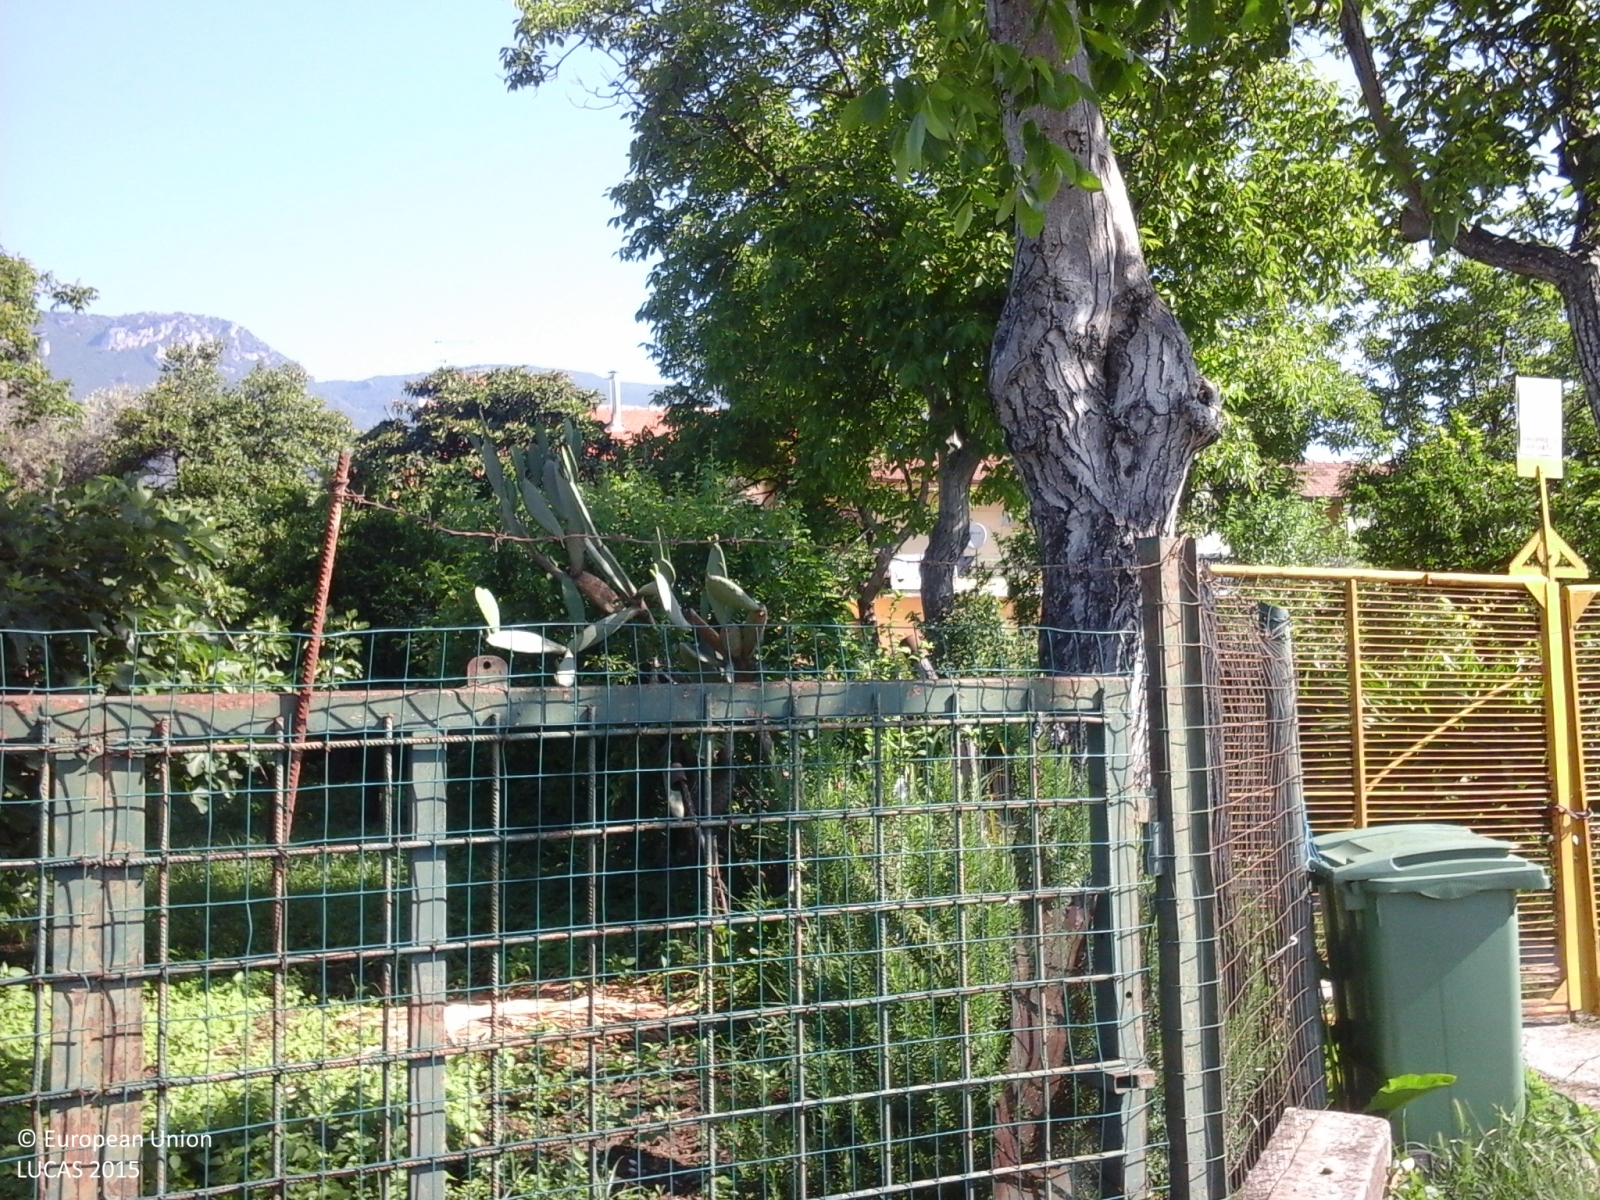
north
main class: Cropland
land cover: Oranges
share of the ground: > 75 %
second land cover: Spontaneously vegetated surfaces
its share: > 75 %
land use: Kitchen garden
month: June
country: IT
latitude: 40.6243
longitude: 15.0978
